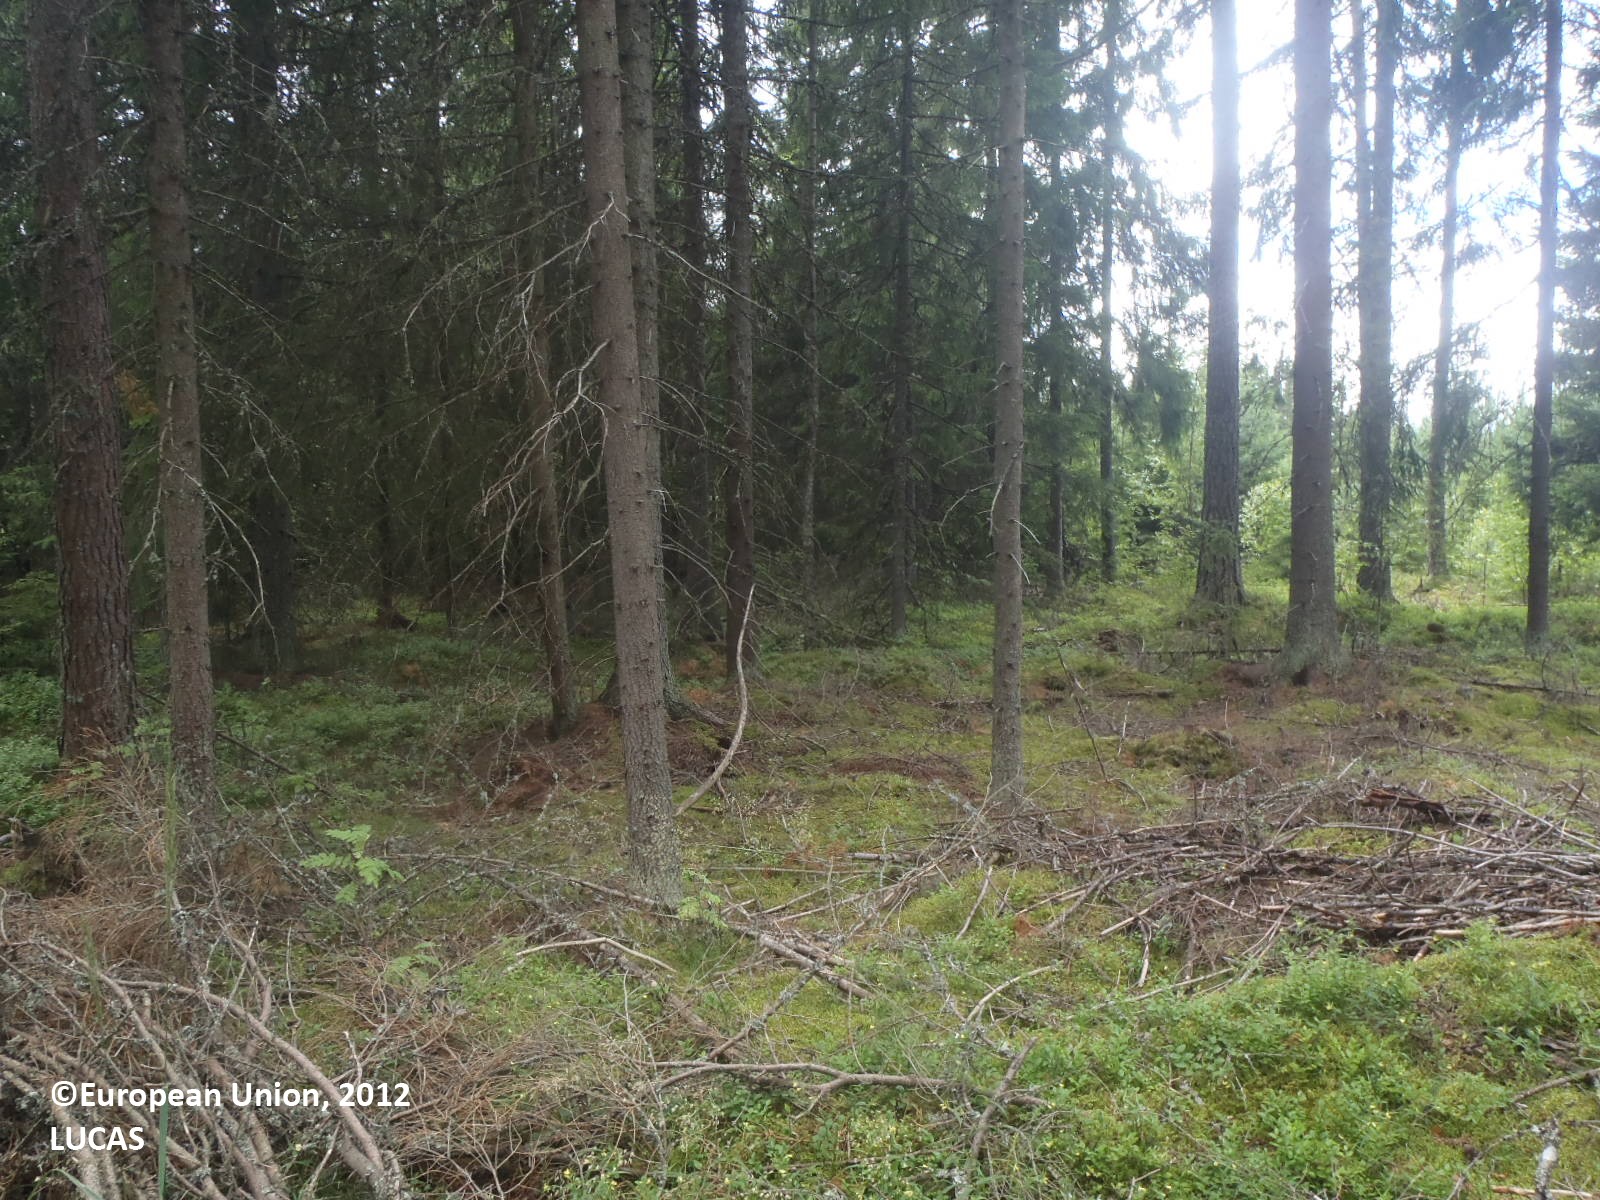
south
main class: Woodland
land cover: Other coniferous woodland
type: boreal forest
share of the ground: 25 - 50 %
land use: Forestry
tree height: > 5 m
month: July
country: FI
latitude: 61.1885
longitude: 21.9064
